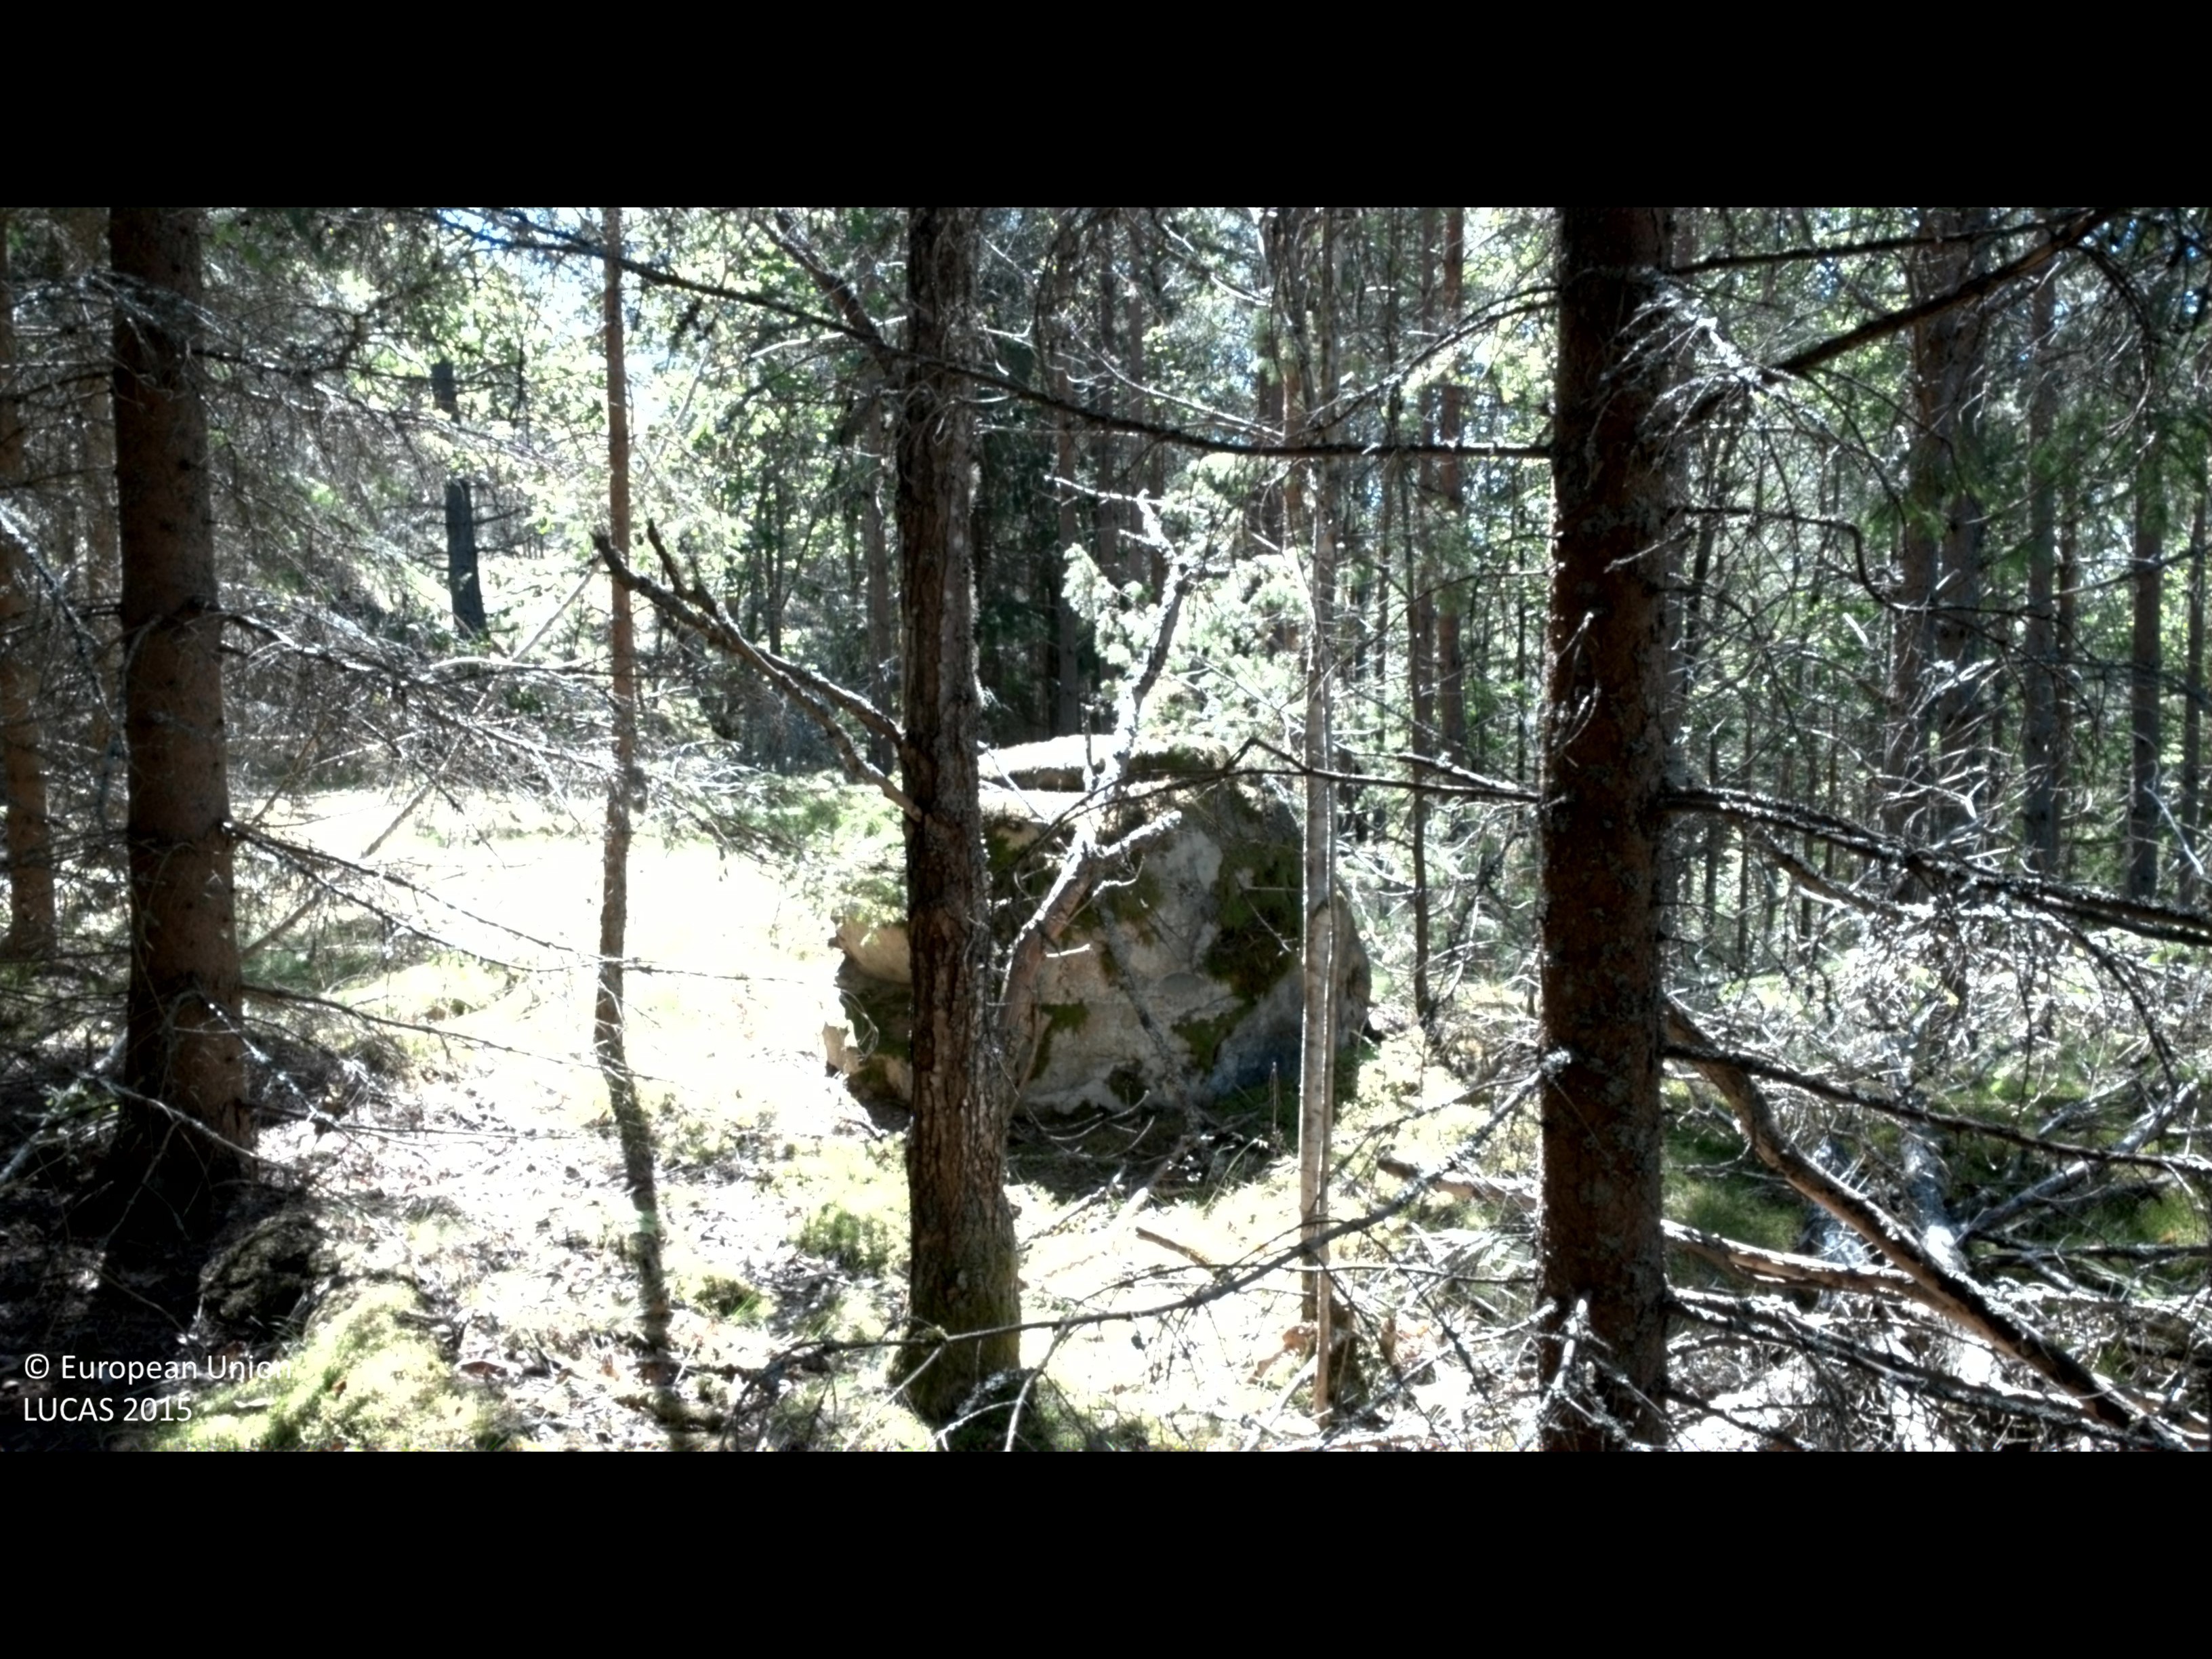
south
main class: Woodland
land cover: Spruce dominated coniferous woodland
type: boreal forest
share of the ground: > 75 %
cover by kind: coniferous forest trees 70 %, broadleaved forest trees 15 %, lichens and mosses 10 %, shrubs 5 %
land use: Forestry
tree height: > 5 m
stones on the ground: < 10 %
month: July
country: SE
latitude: 58.1831
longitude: 16.6129
